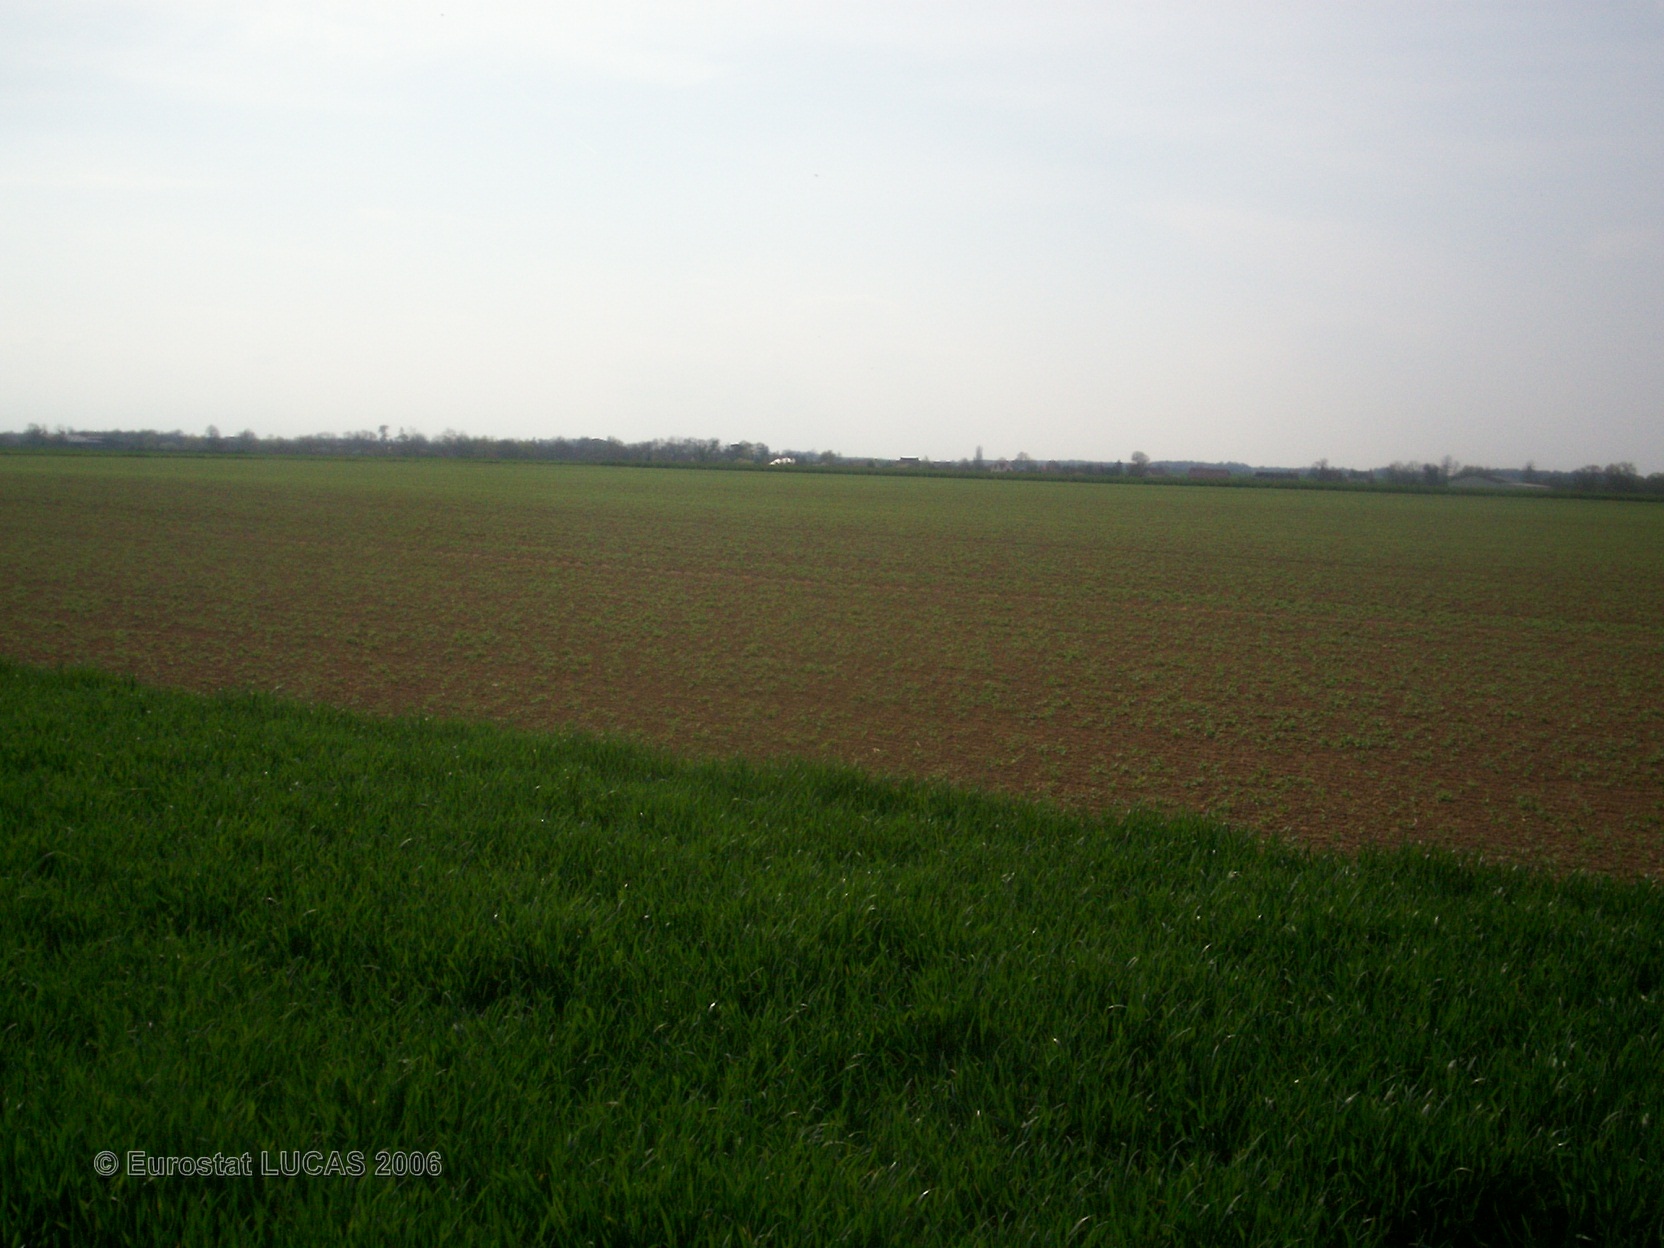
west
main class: Cropland
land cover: Common wheat
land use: Agriculture (excluding fallow land and kitchen gardens)
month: April
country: FR
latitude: 49.0647
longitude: -0.0914
